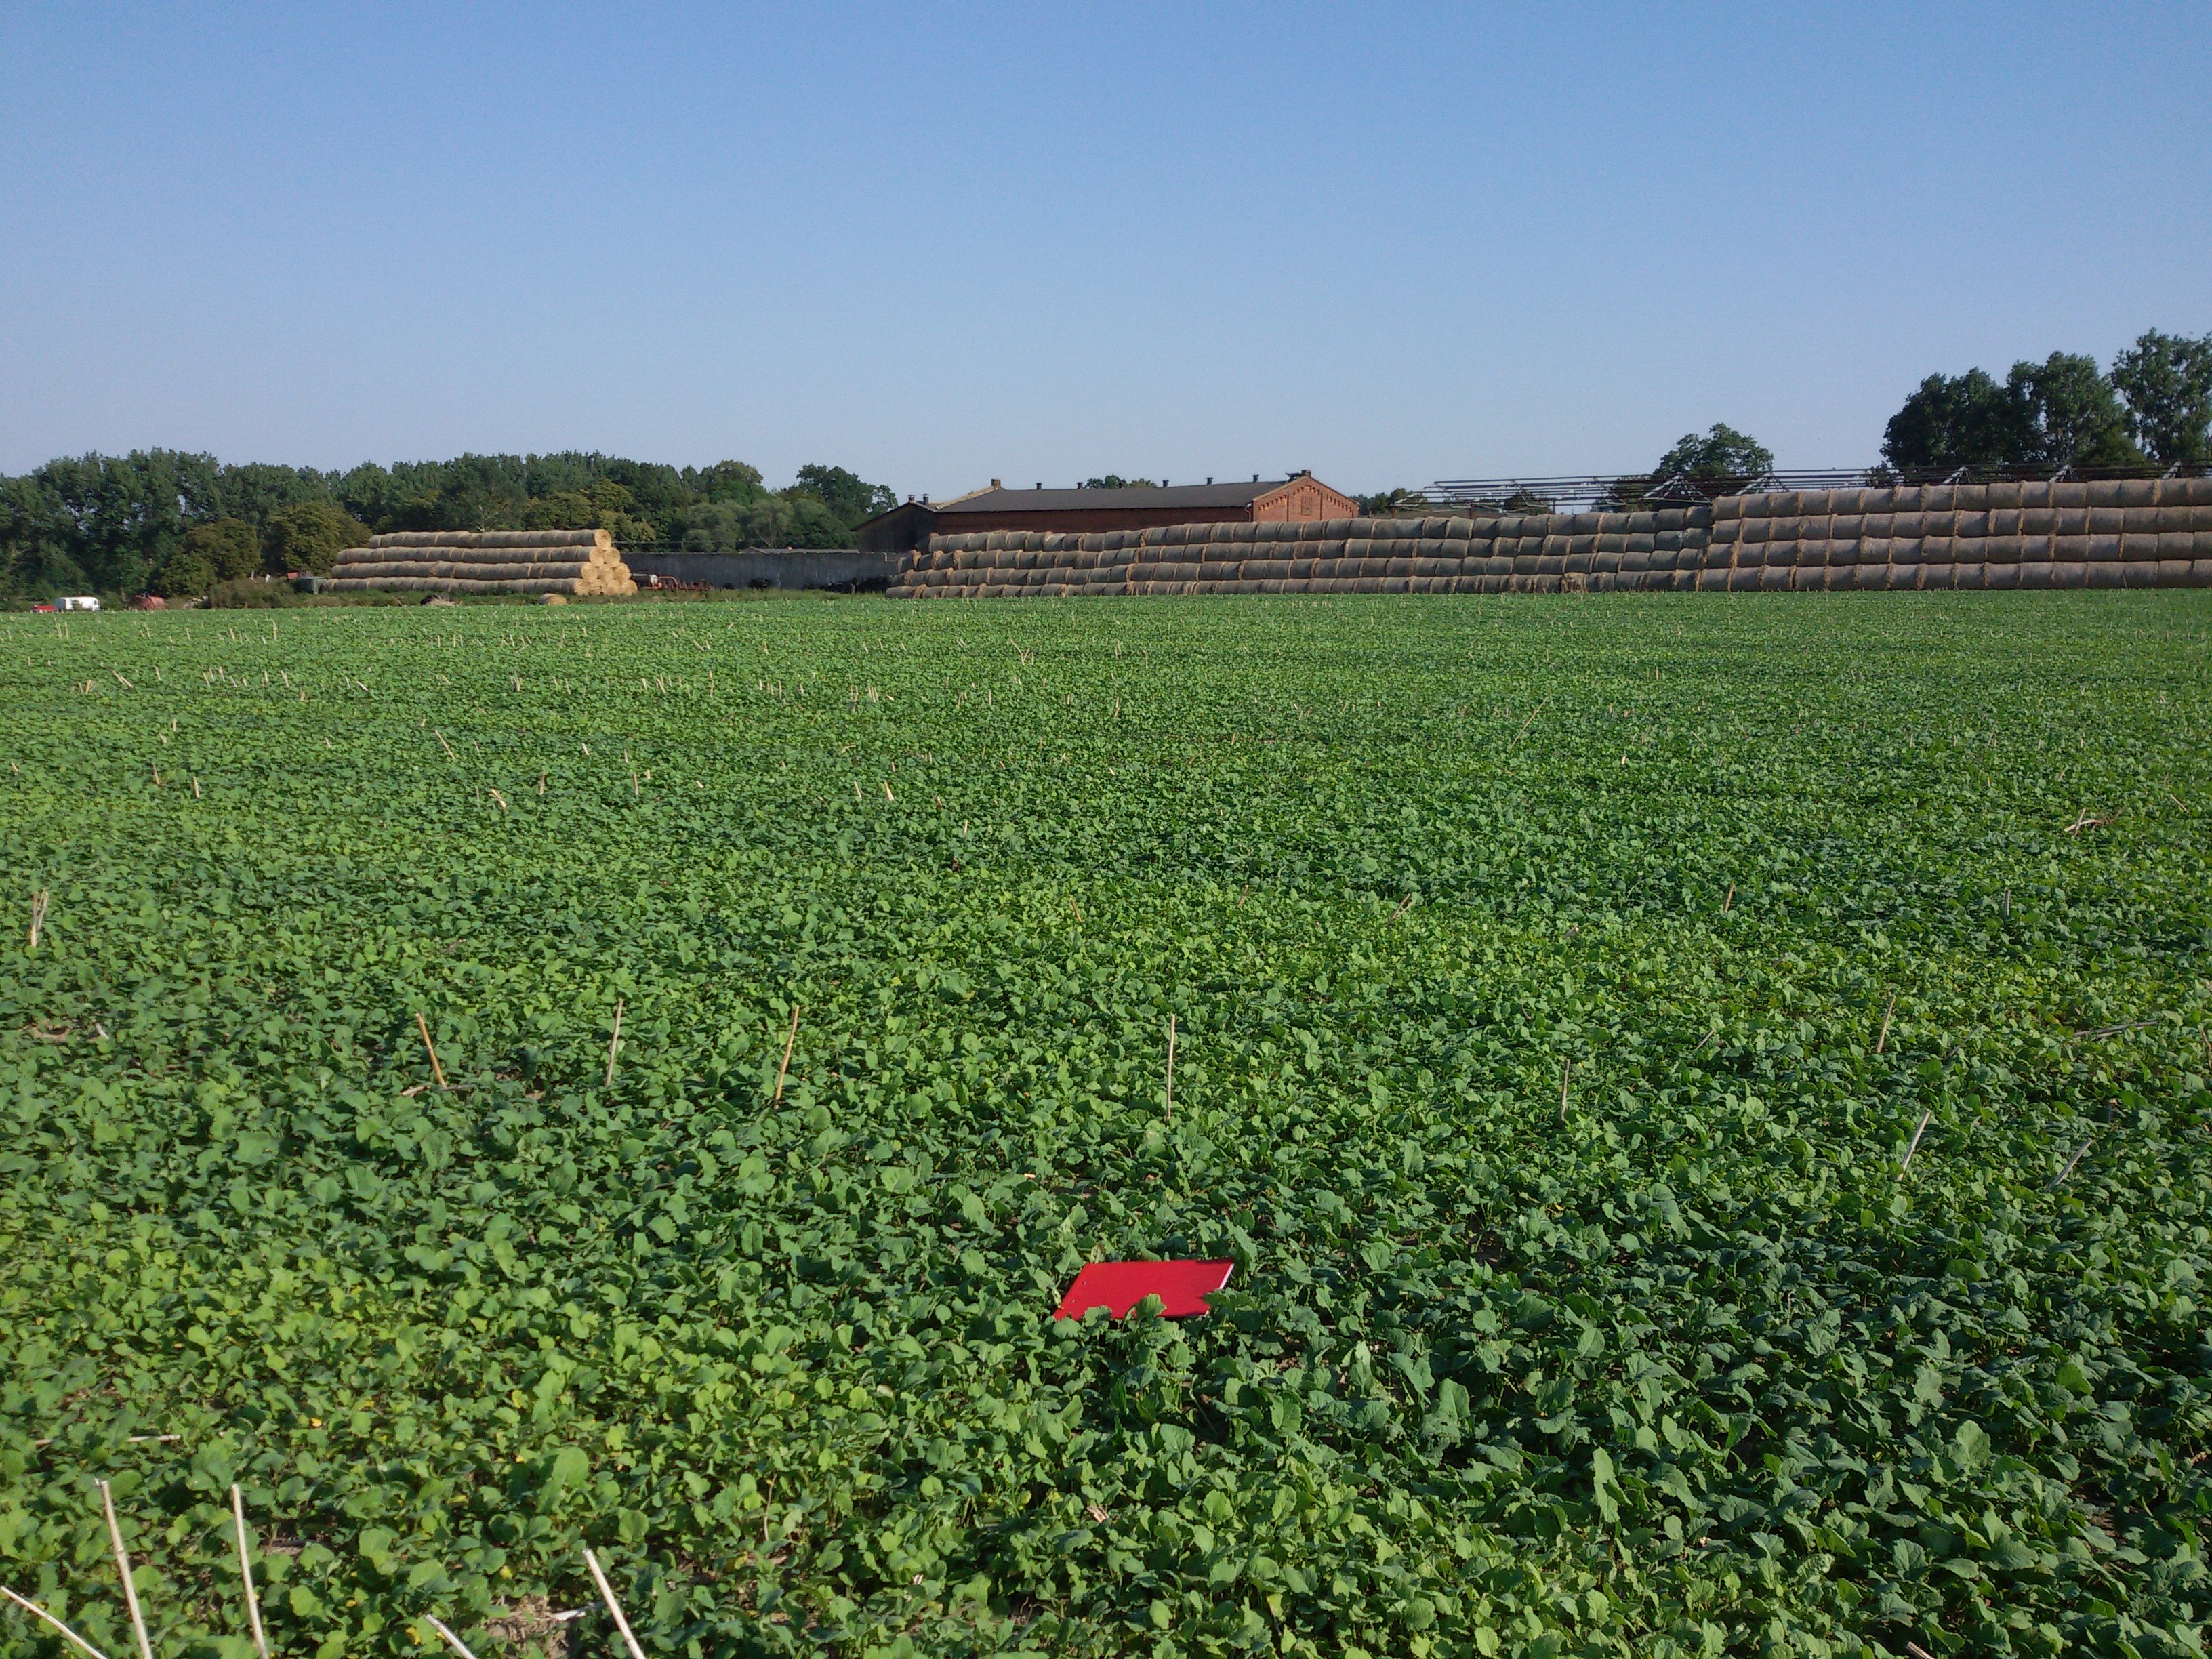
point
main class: Cropland
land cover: Rape and turnip rape
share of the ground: > 75 %
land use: Agriculture (excluding fallow land and kitchen gardens)
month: August
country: PL
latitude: 52.5683
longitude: 17.5815
